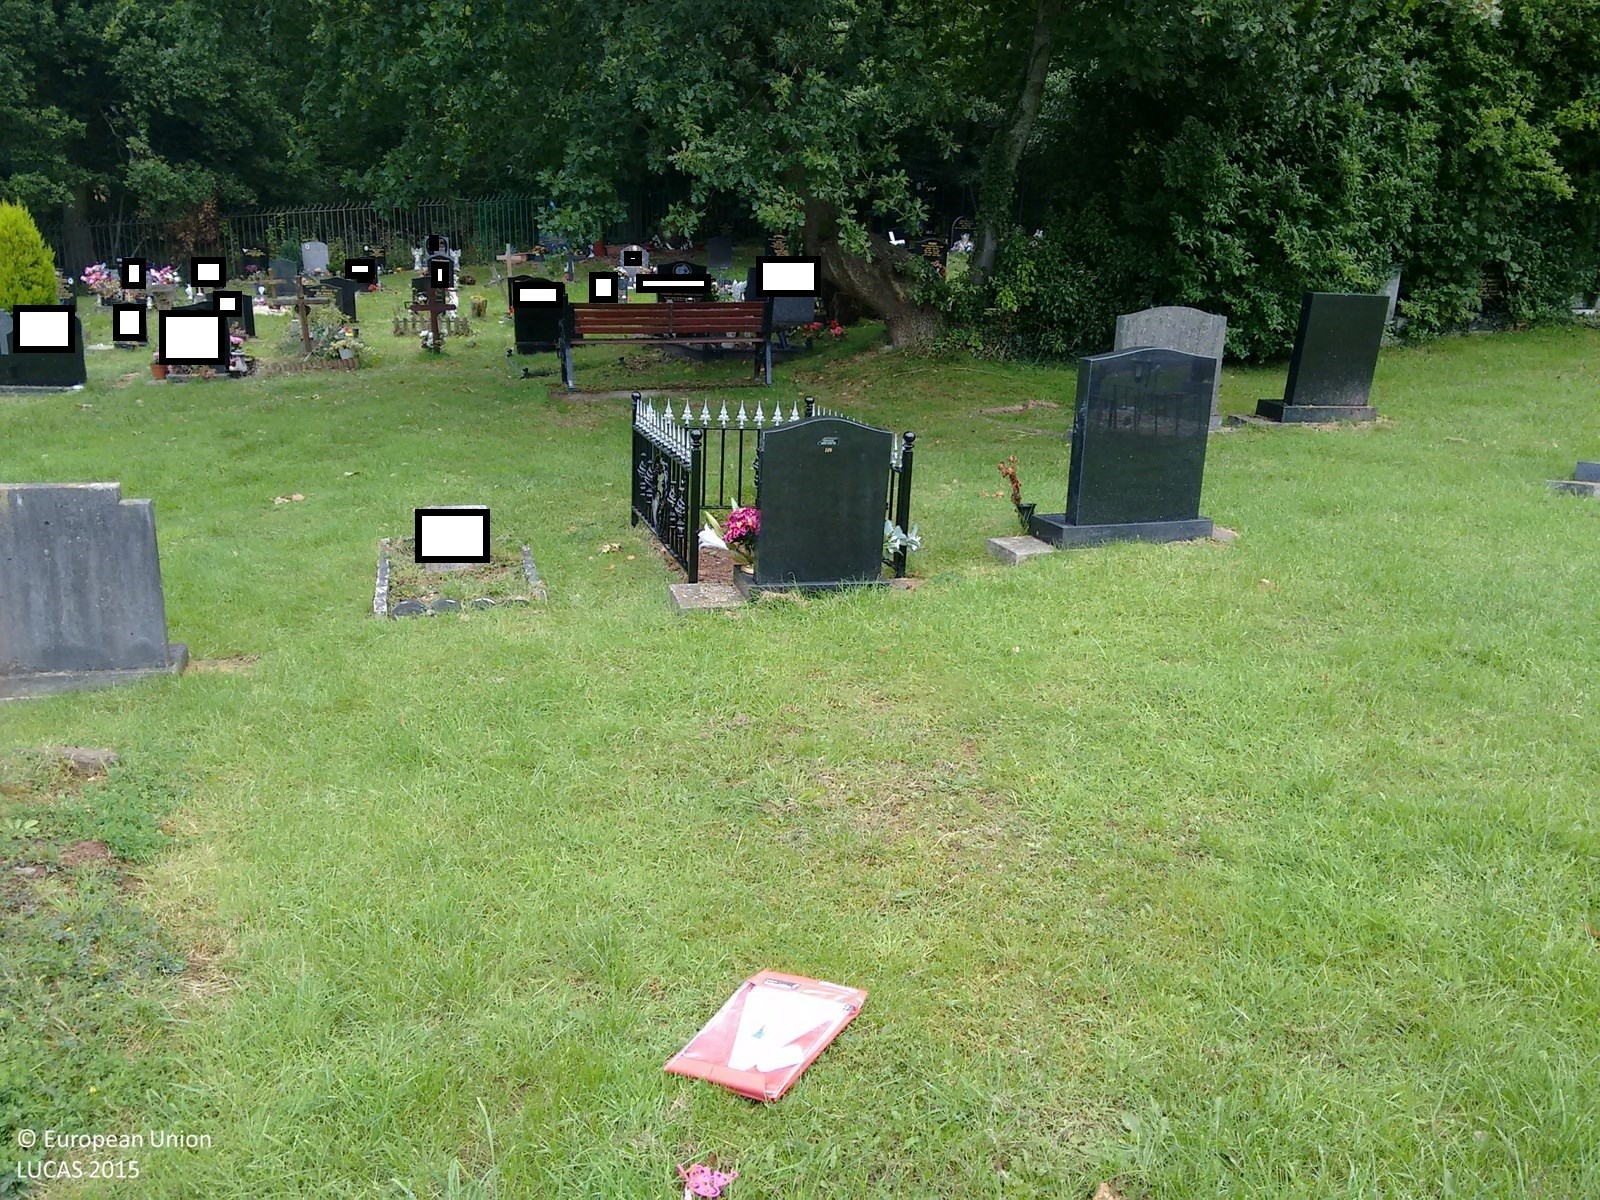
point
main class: Grassland
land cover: Grassland without tree/shrub cover
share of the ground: > 75 %
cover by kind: herbaceous plants 100 %
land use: Community services
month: September
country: GB
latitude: 51.5835
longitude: -3.0210
